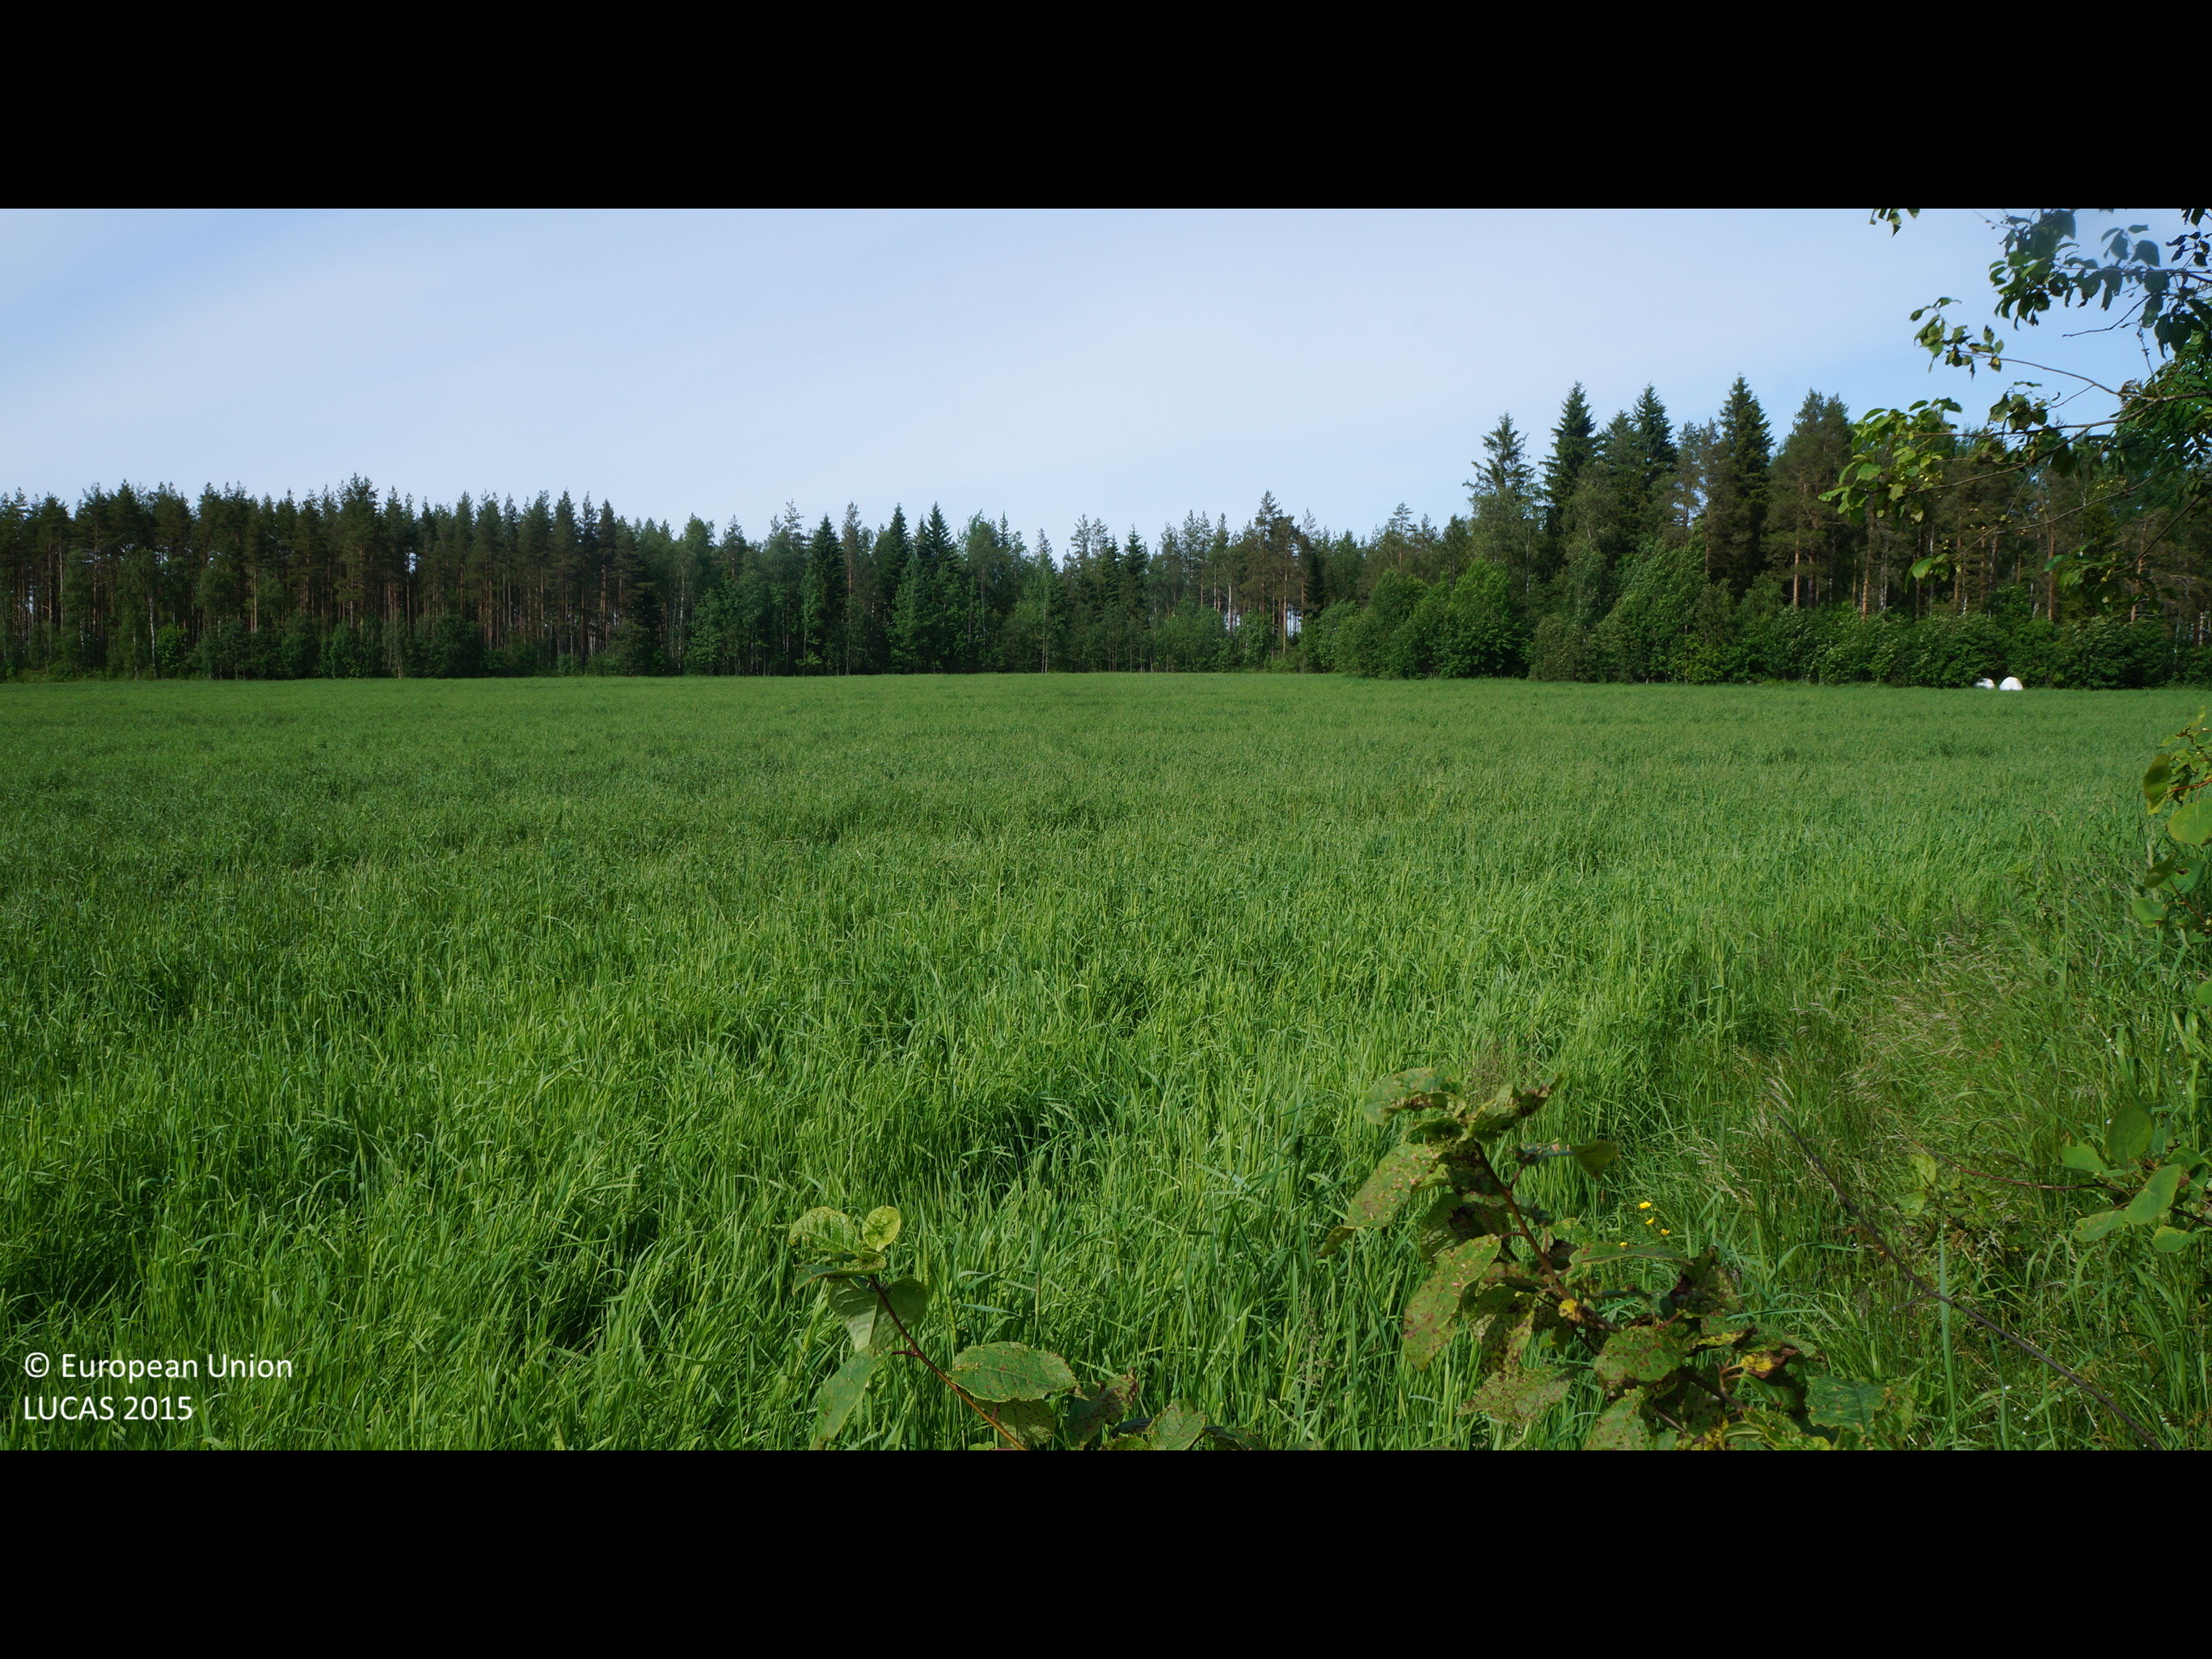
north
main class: Cropland
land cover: Temporary grasslands
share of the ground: > 75 %
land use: Agriculture (excluding fallow land and kitchen gardens)
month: July
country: FI
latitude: 64.1851
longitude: 24.3328
